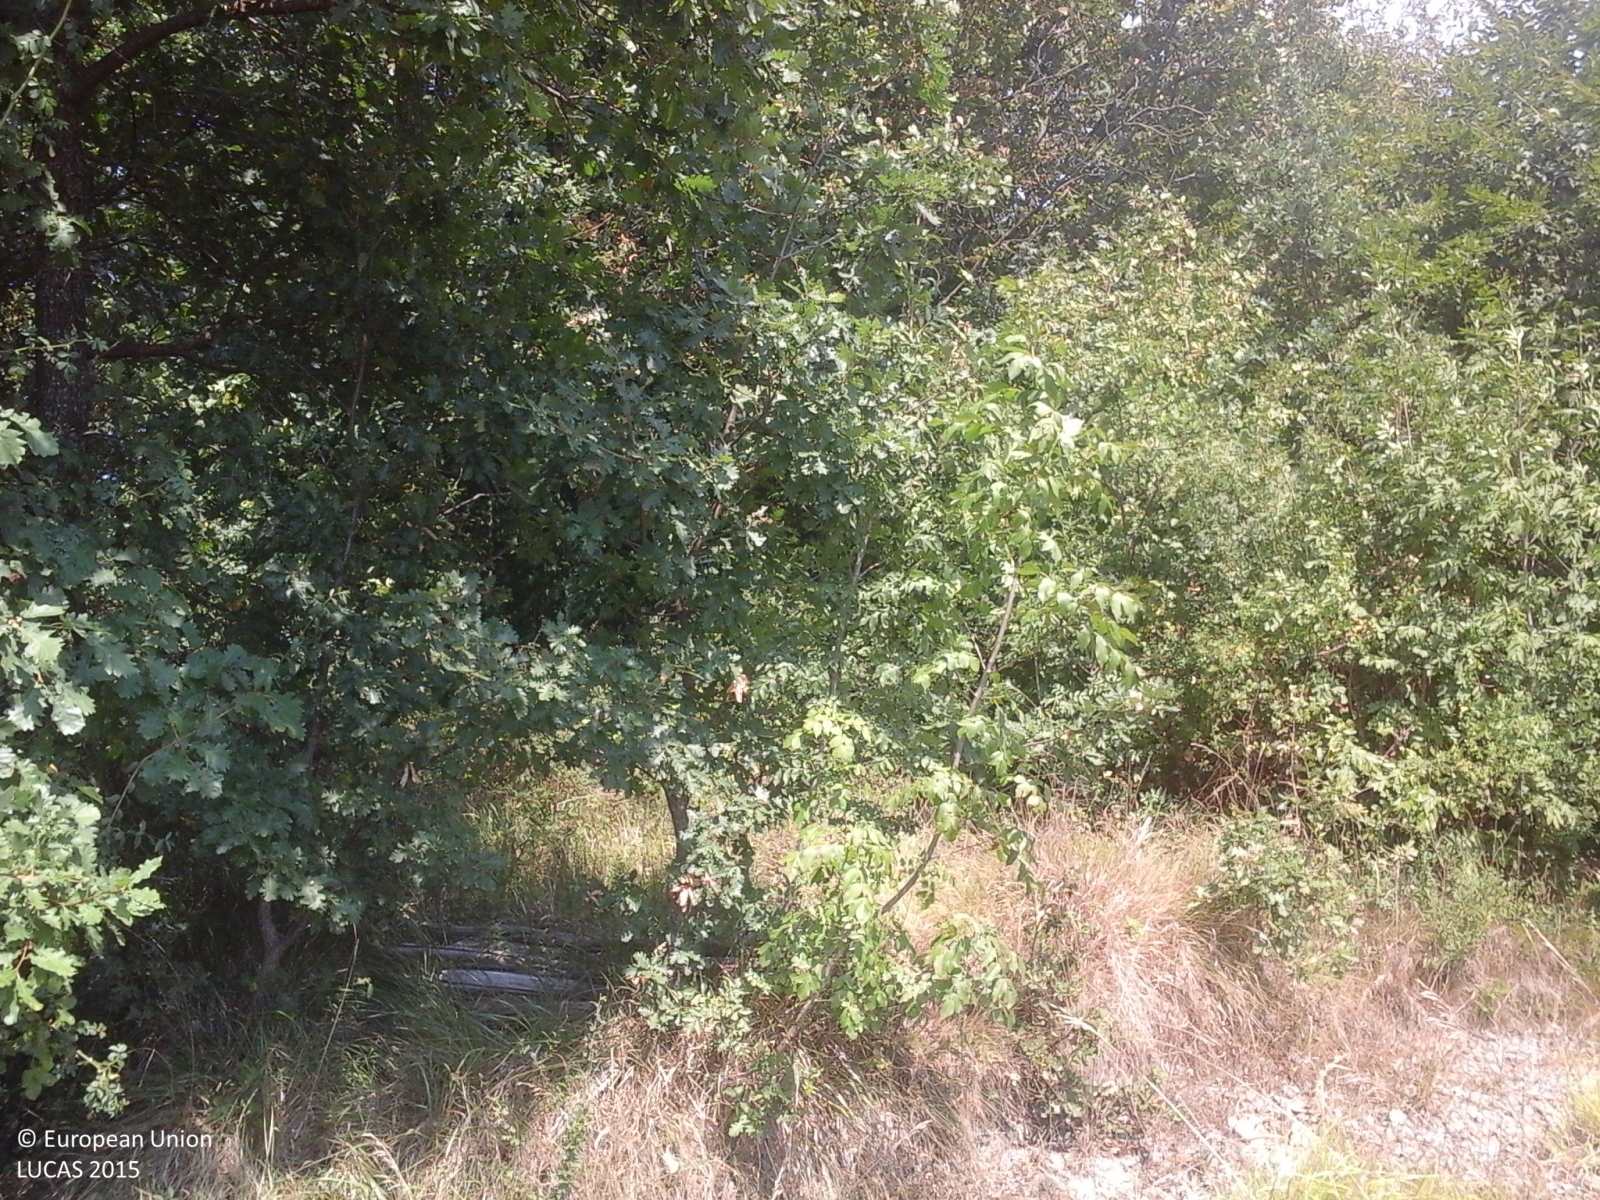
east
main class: Grassland
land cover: Grassland without tree/shrub cover
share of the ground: > 75 %
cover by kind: herbaceous plants 95 %, shrubs 5 %
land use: Semi-natural and natural areas not in use
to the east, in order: Grassland without tree/shrub cover; Abandoned hedges; Fences; Broadleaved woodland; Paved roads, cycling and walking lanes; Fences; Grassland with sparse tree/shrub cover; Fences; Broadleaved woodland
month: August
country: IT
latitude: 44.3498
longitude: 9.6120
